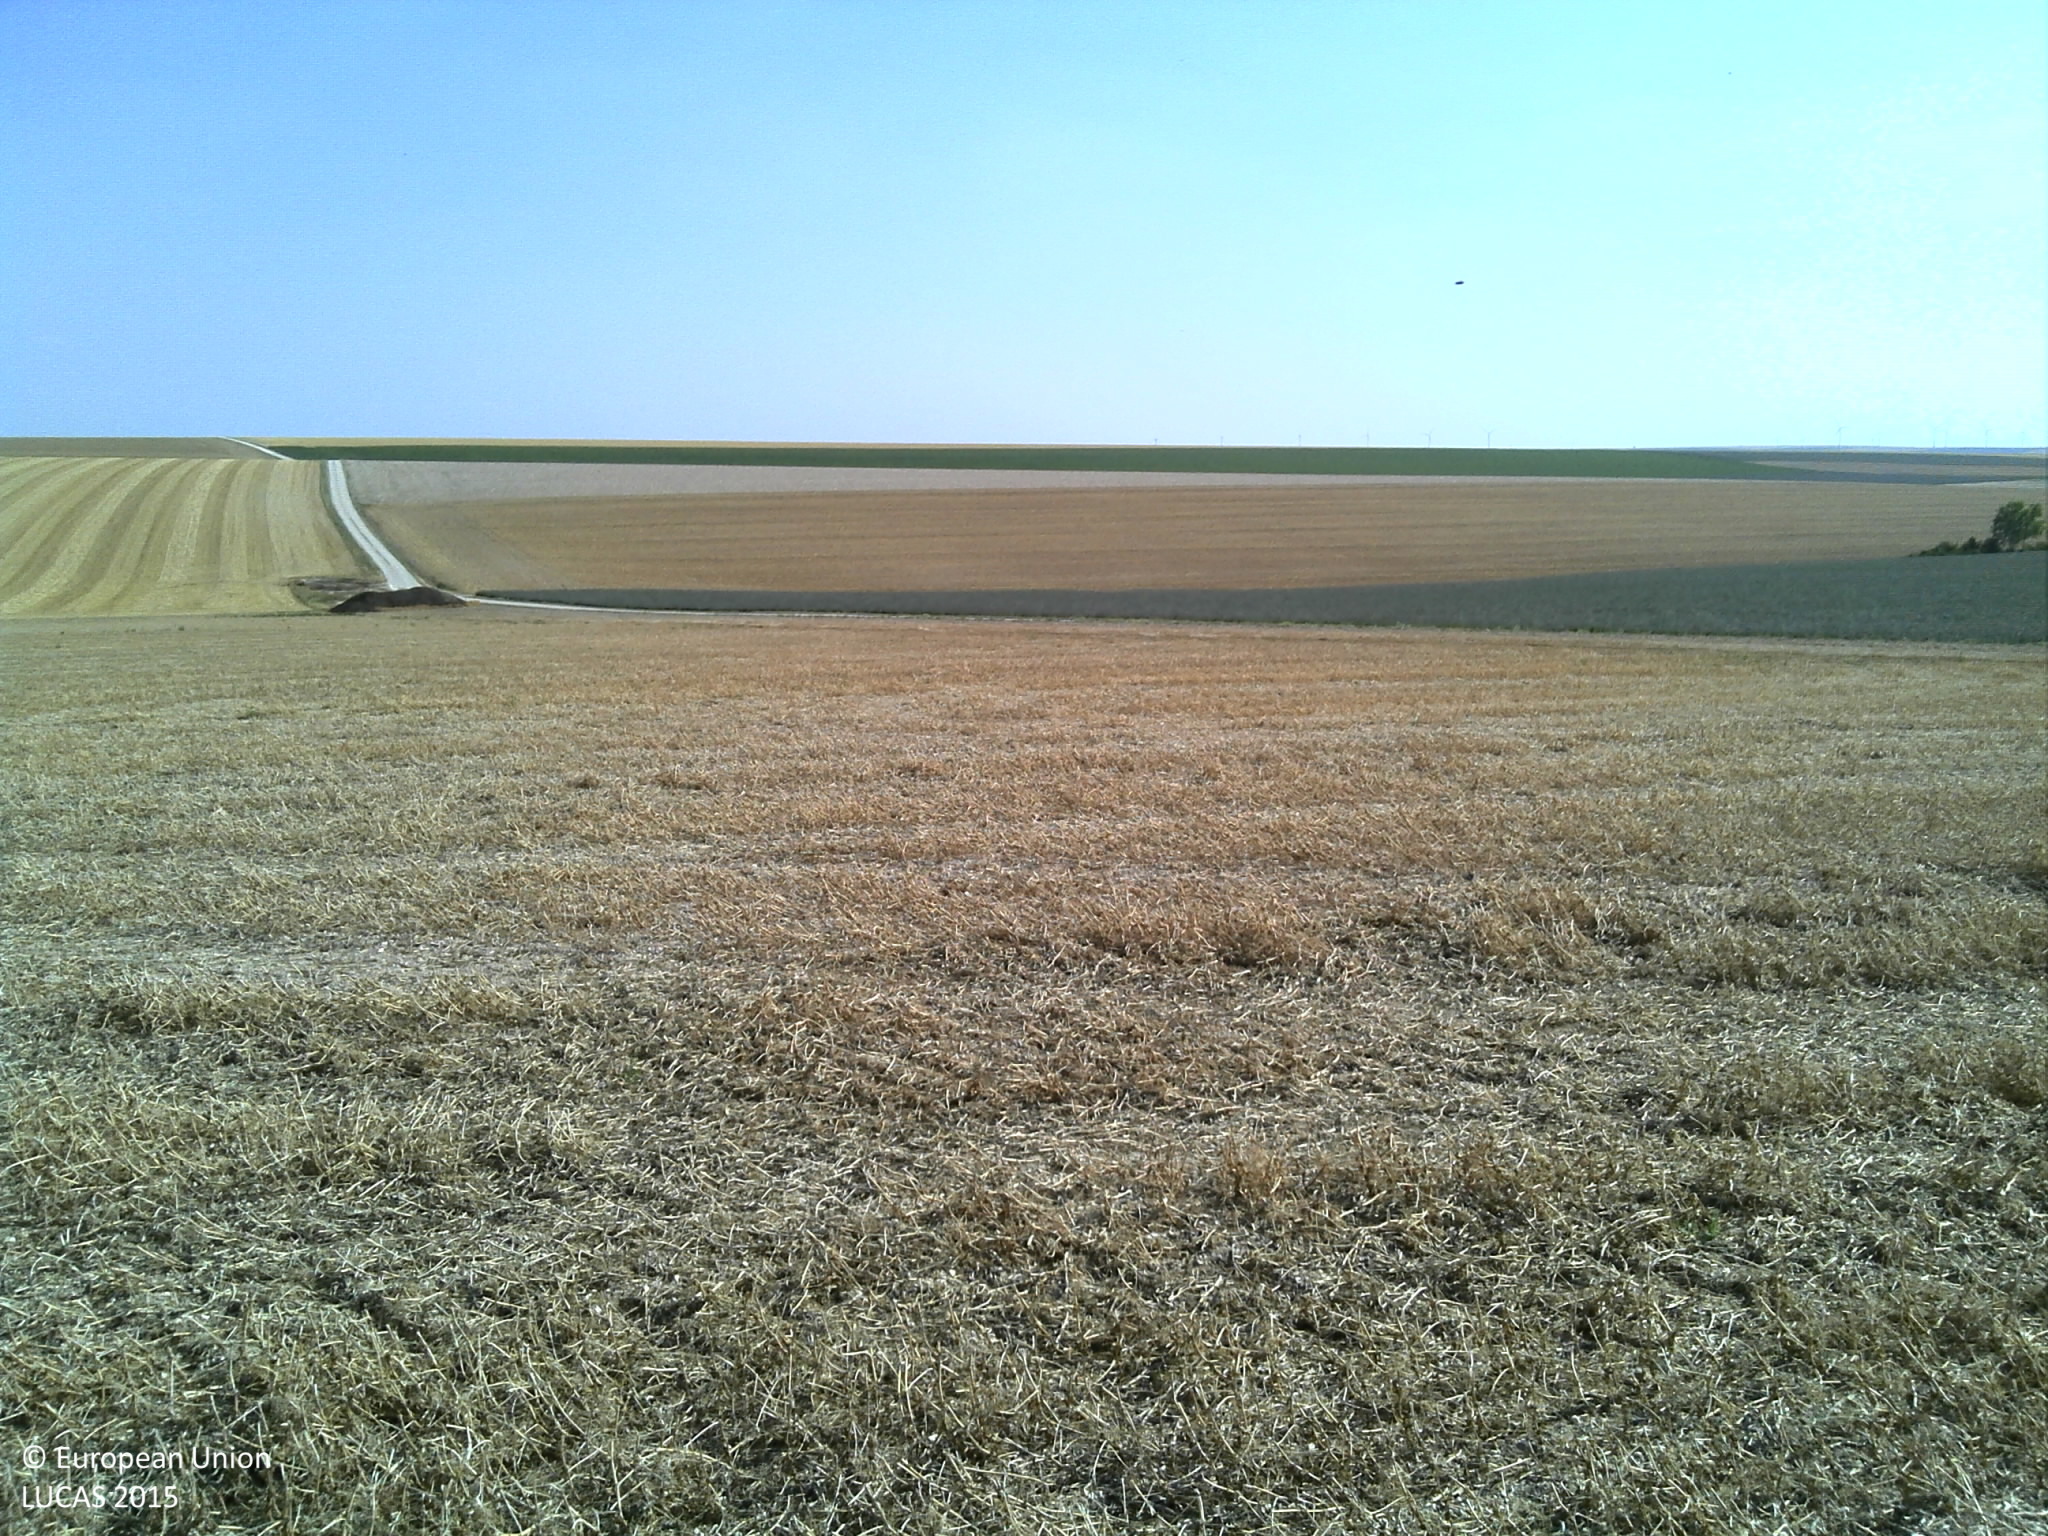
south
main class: Cropland
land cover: Dry pulses
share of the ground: > 75 %
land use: Agriculture (excluding fallow land and kitchen gardens)
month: August
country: FR
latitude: 48.9402
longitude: 4.6316
